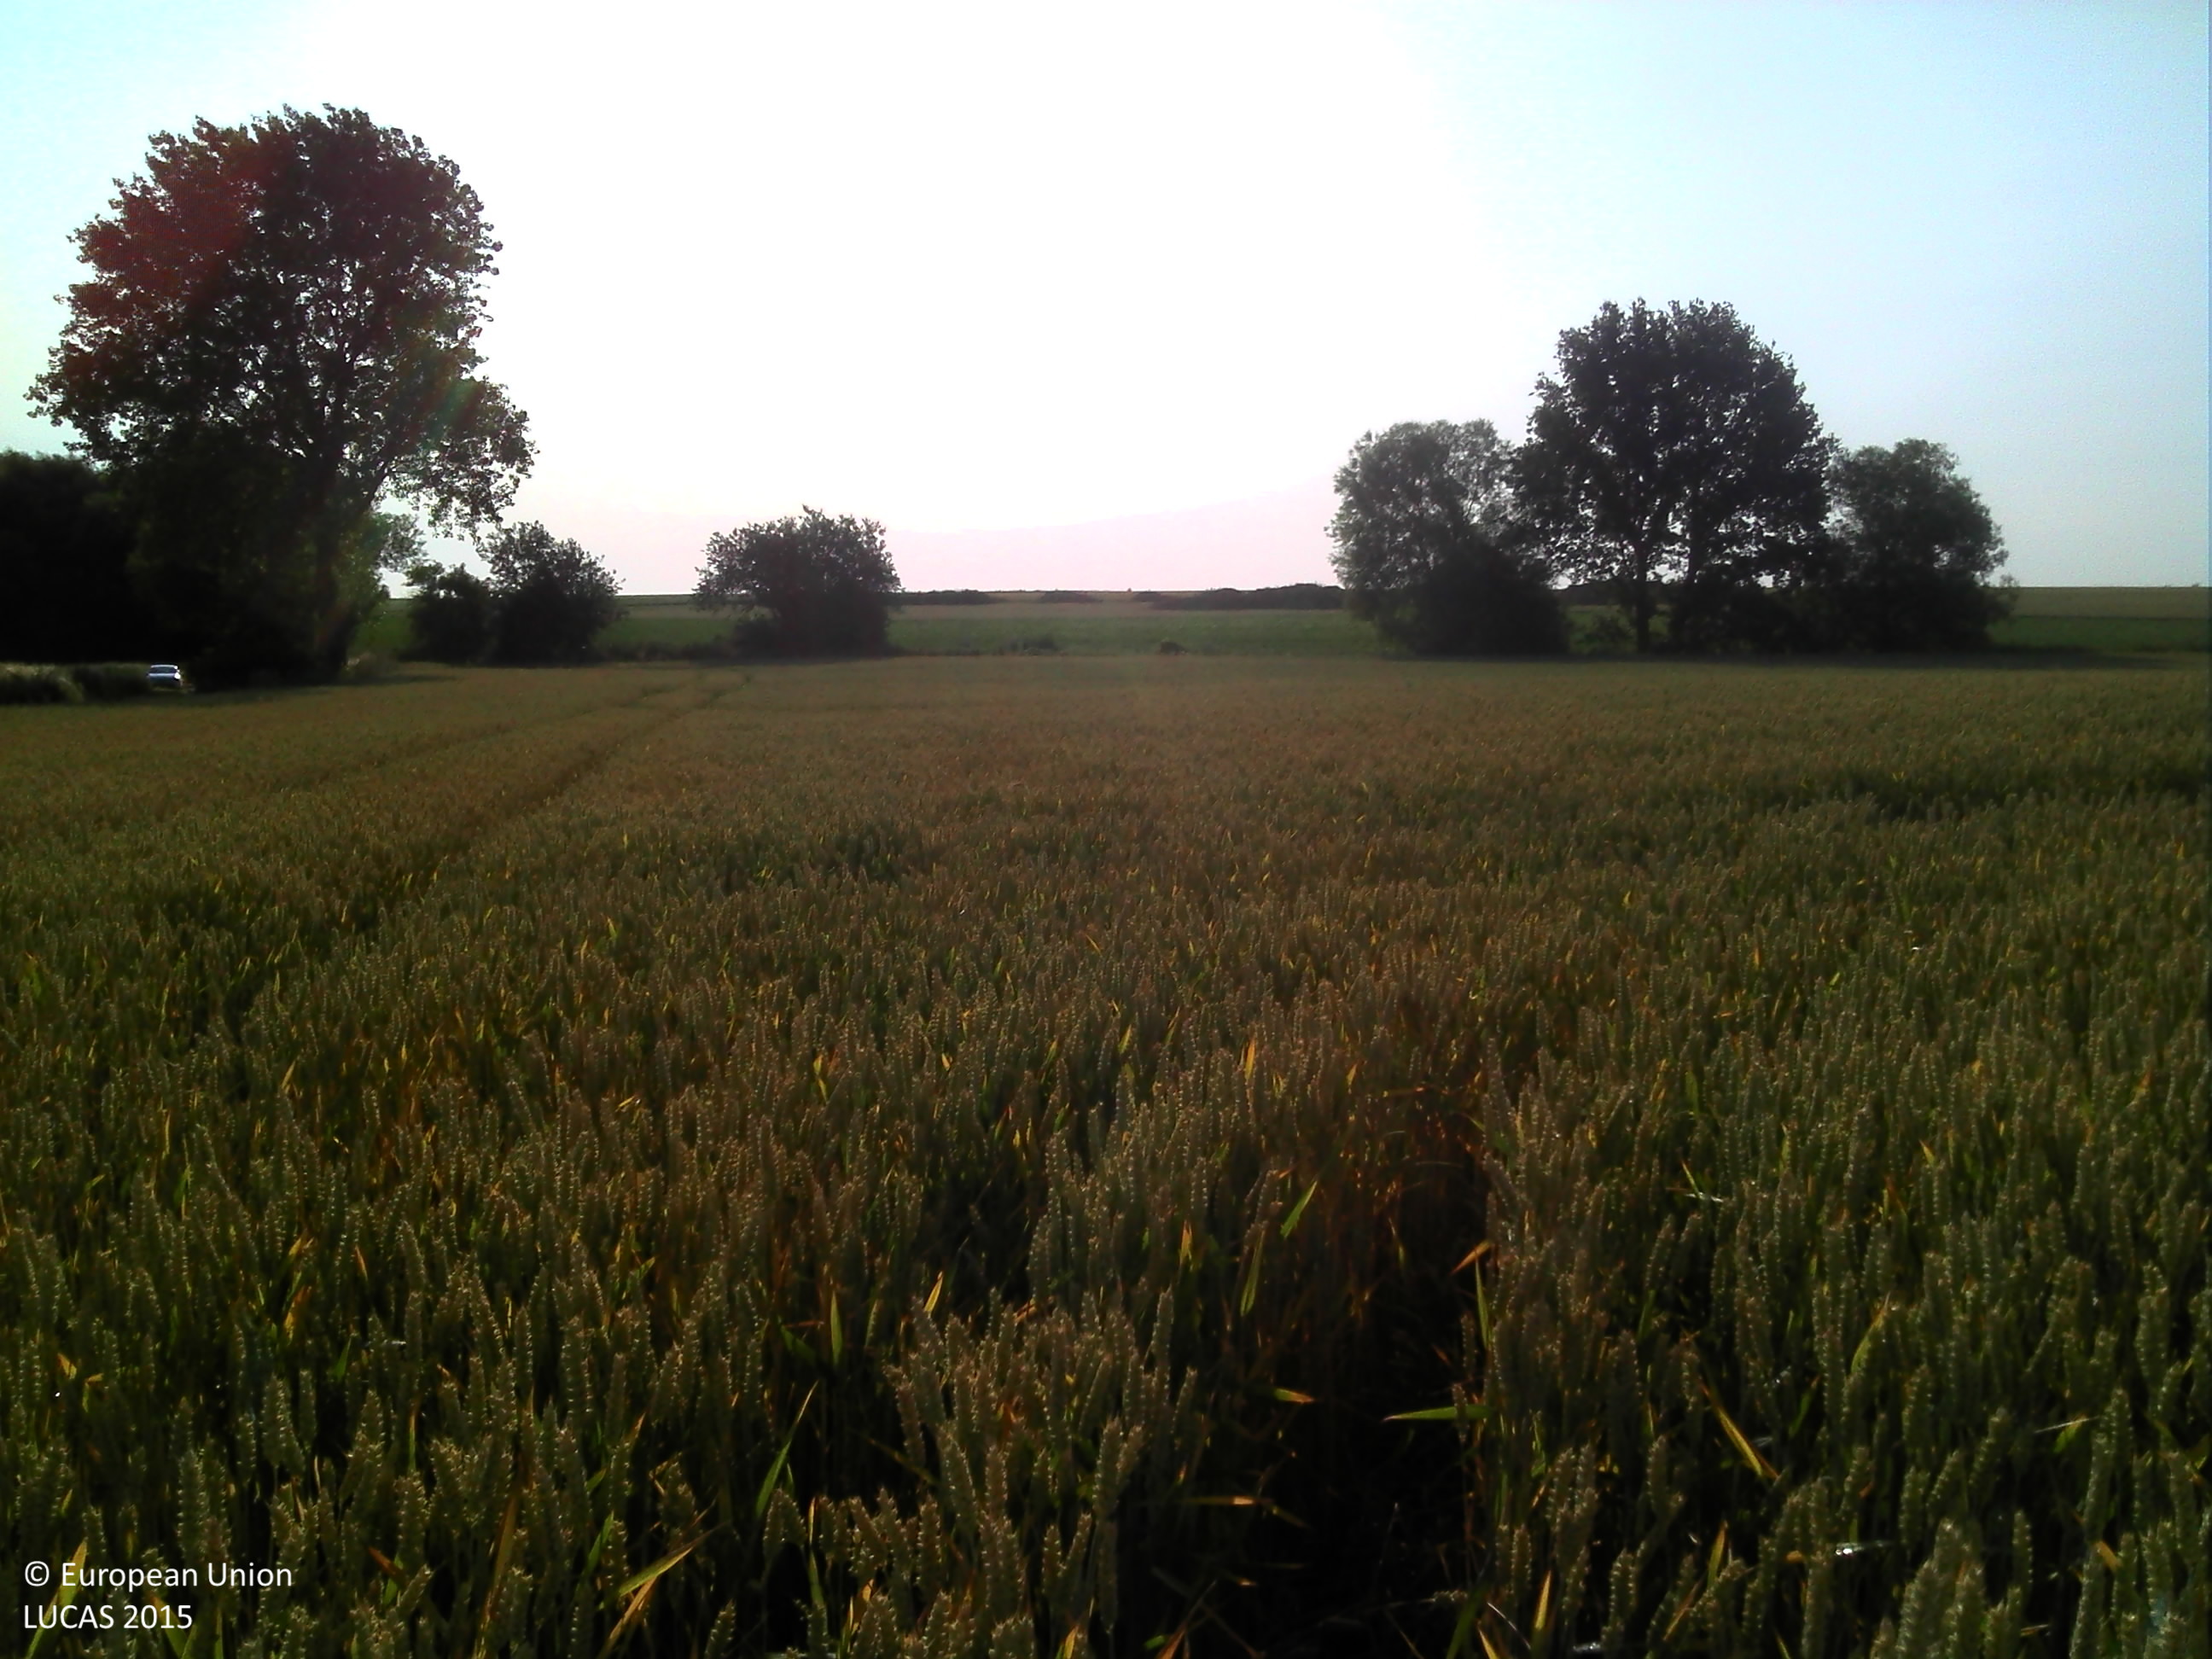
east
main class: Cropland
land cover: Common wheat
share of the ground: > 75 %
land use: Agriculture (excluding fallow land and kitchen gardens)
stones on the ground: < 10 %
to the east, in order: Common wheat; Grass margins; Ditches and canals; Grass margins; Potatoes; Common wheat
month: July
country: BE
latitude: 50.7099
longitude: 5.1117
